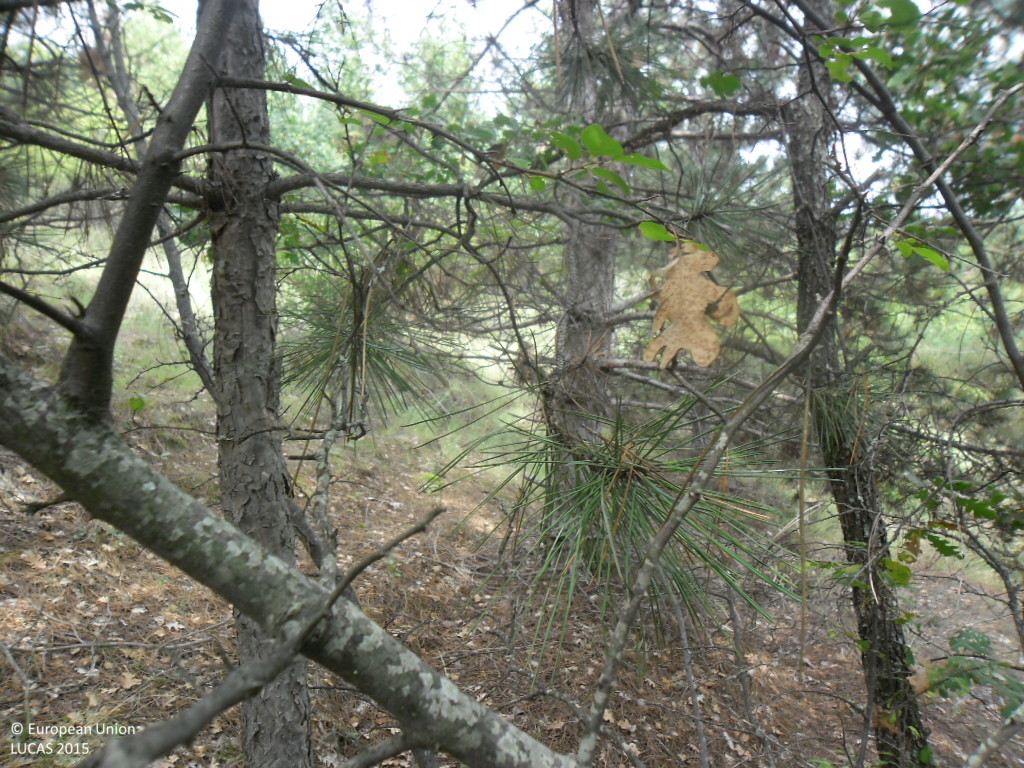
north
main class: Woodland
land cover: Other mixed woodland
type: hemiboreal forest and nemoral coniferous forest and mixed broadleaved-coniferous forest
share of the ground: > 75 %
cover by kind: coniferous forest trees 75 %, broadleaved forest trees 25 %
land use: Forestry
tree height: > 5 m
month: September
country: BG
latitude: 41.4014
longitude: 23.0671
